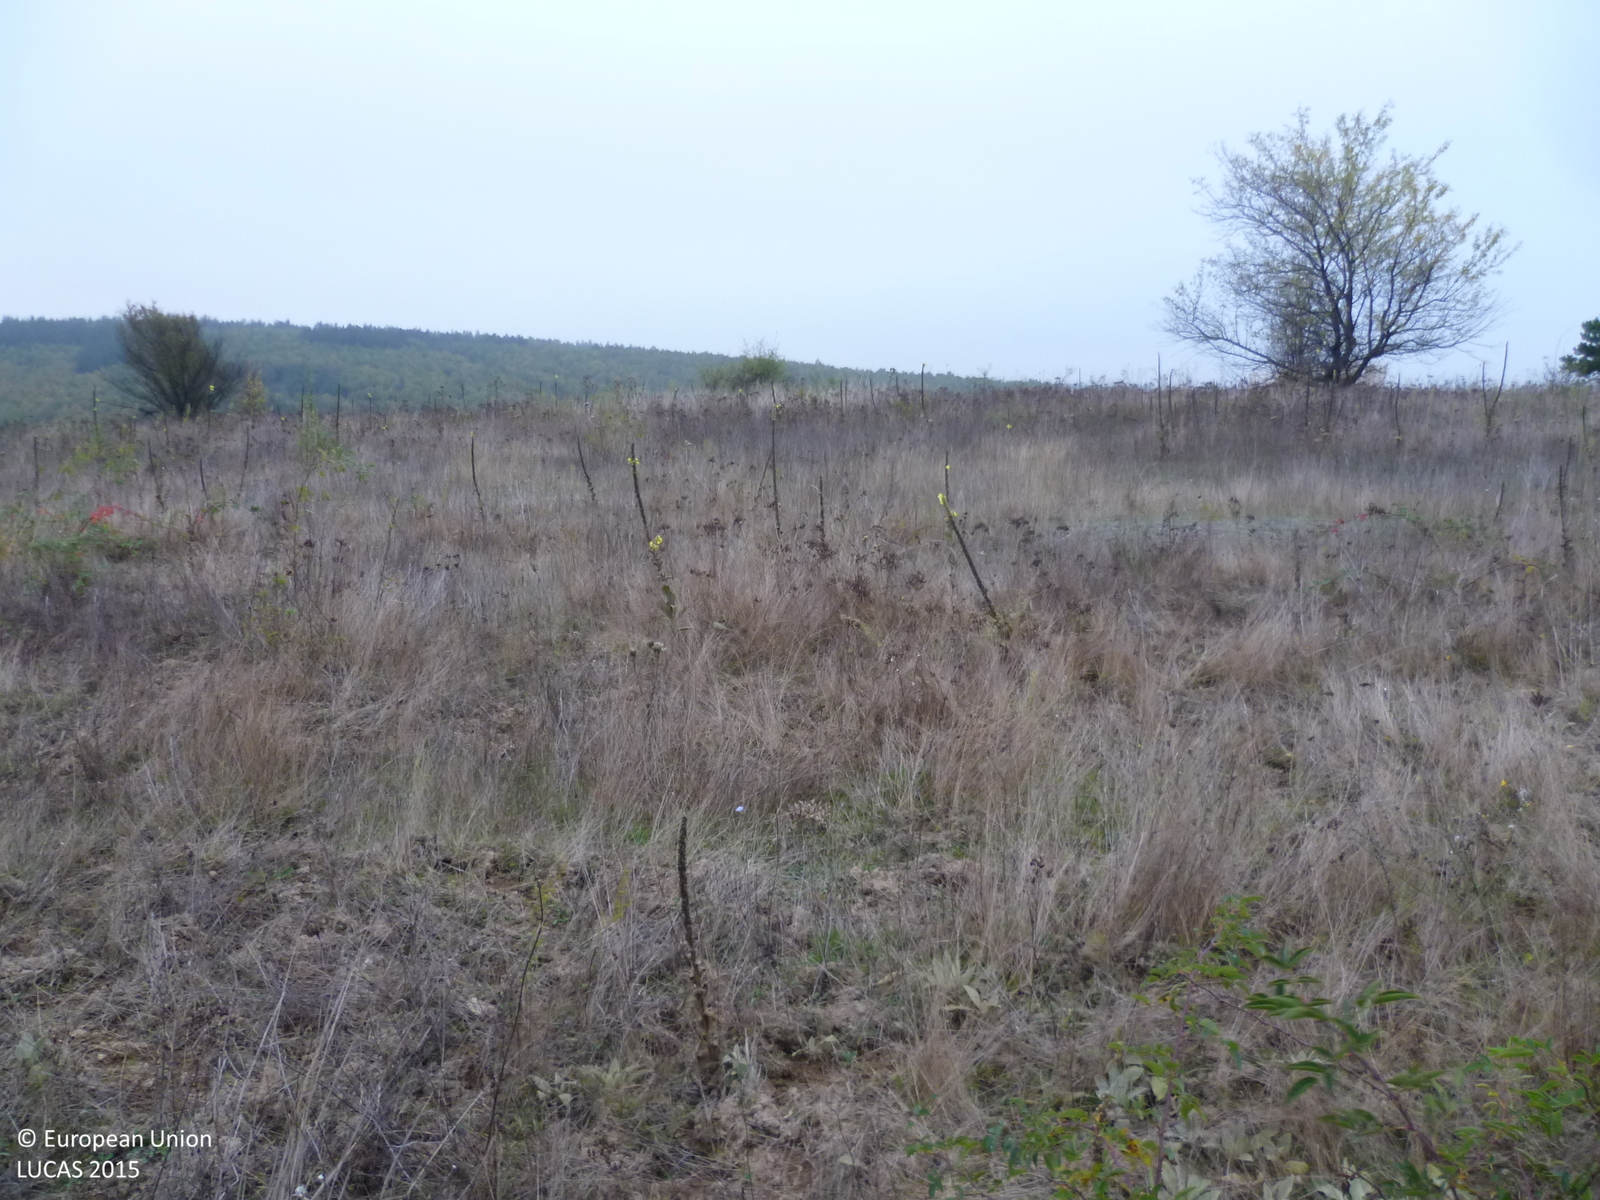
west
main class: Grassland
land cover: Grassland with sparse tree/shrub cover
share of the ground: > 75 %
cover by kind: herbaceous plants 90 %, broadleaved forest trees 5 %, shrubs 5 %
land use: Agriculture (excluding fallow land and kitchen gardens)
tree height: < 5 m
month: October
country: BG
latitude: 42.5152
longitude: 23.7562
